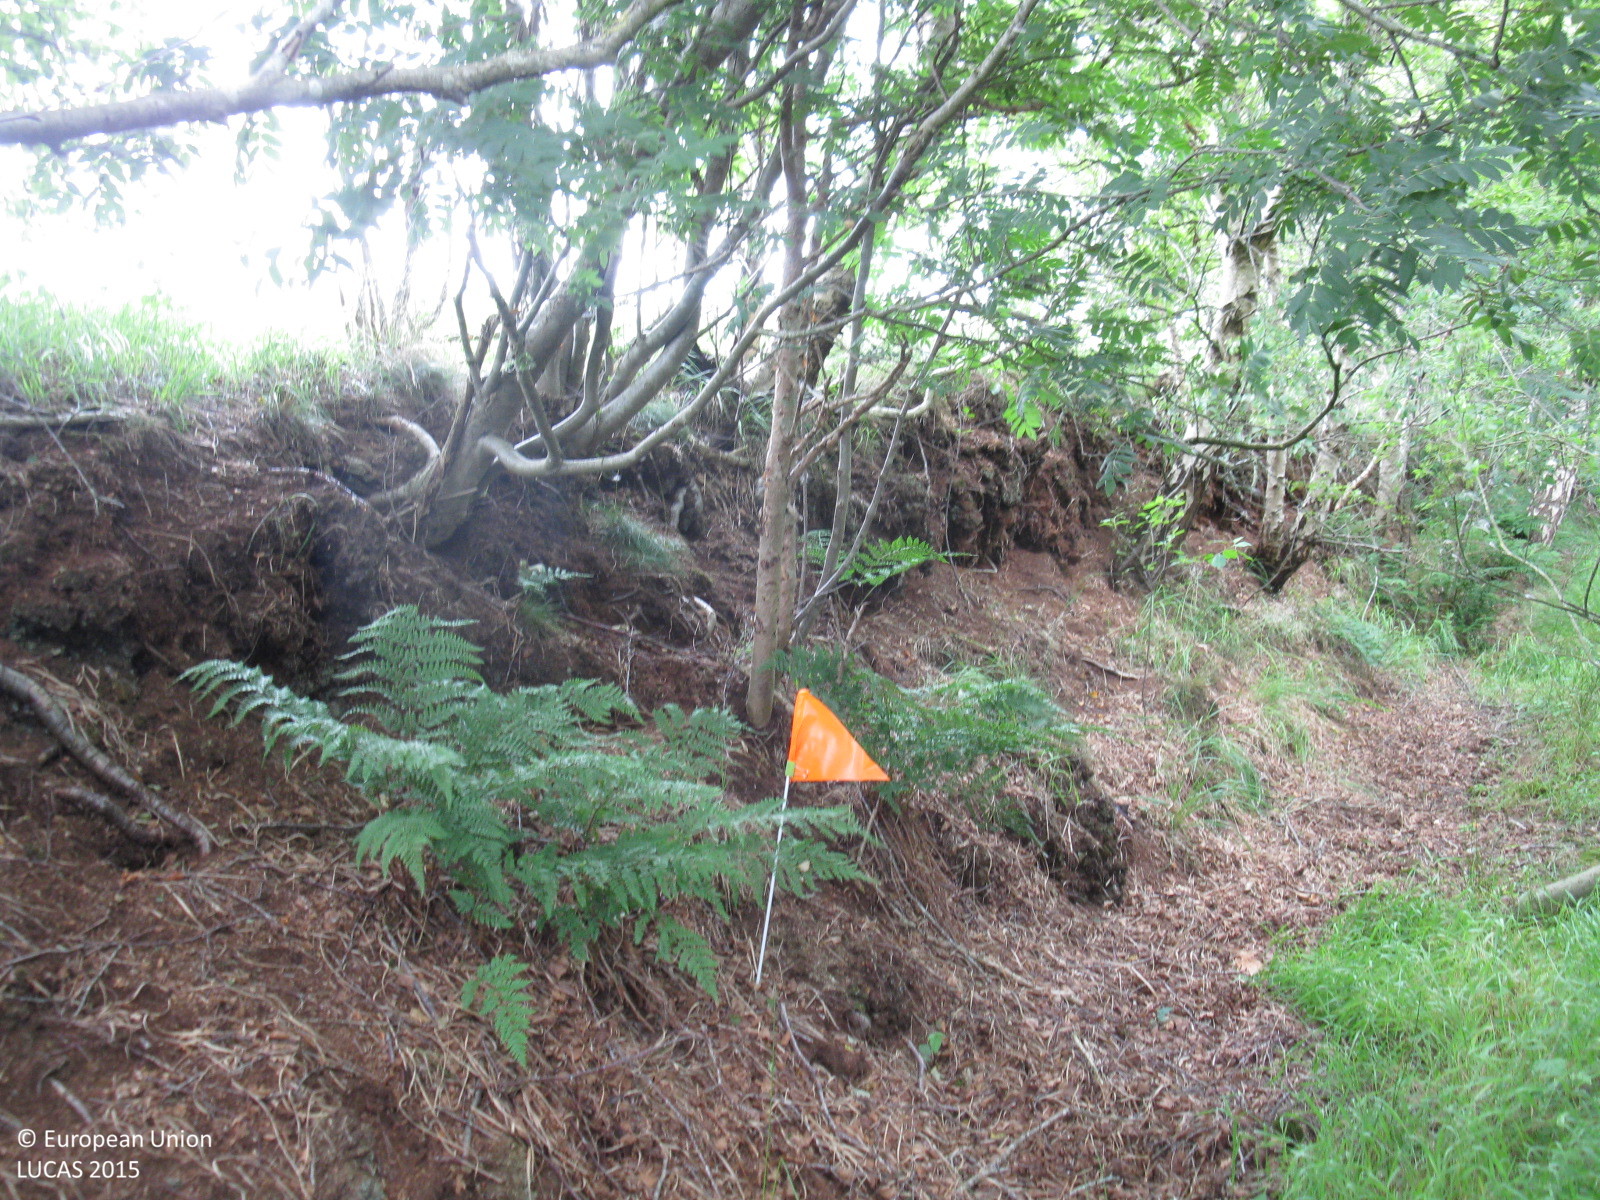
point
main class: Woodland
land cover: Broadleaved woodland
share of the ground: > 75 %
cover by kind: broadleaved forest trees 100 %
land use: Semi-natural and natural areas not in use
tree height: > 5 m
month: July
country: DE
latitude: 53.3475
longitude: 7.8826
